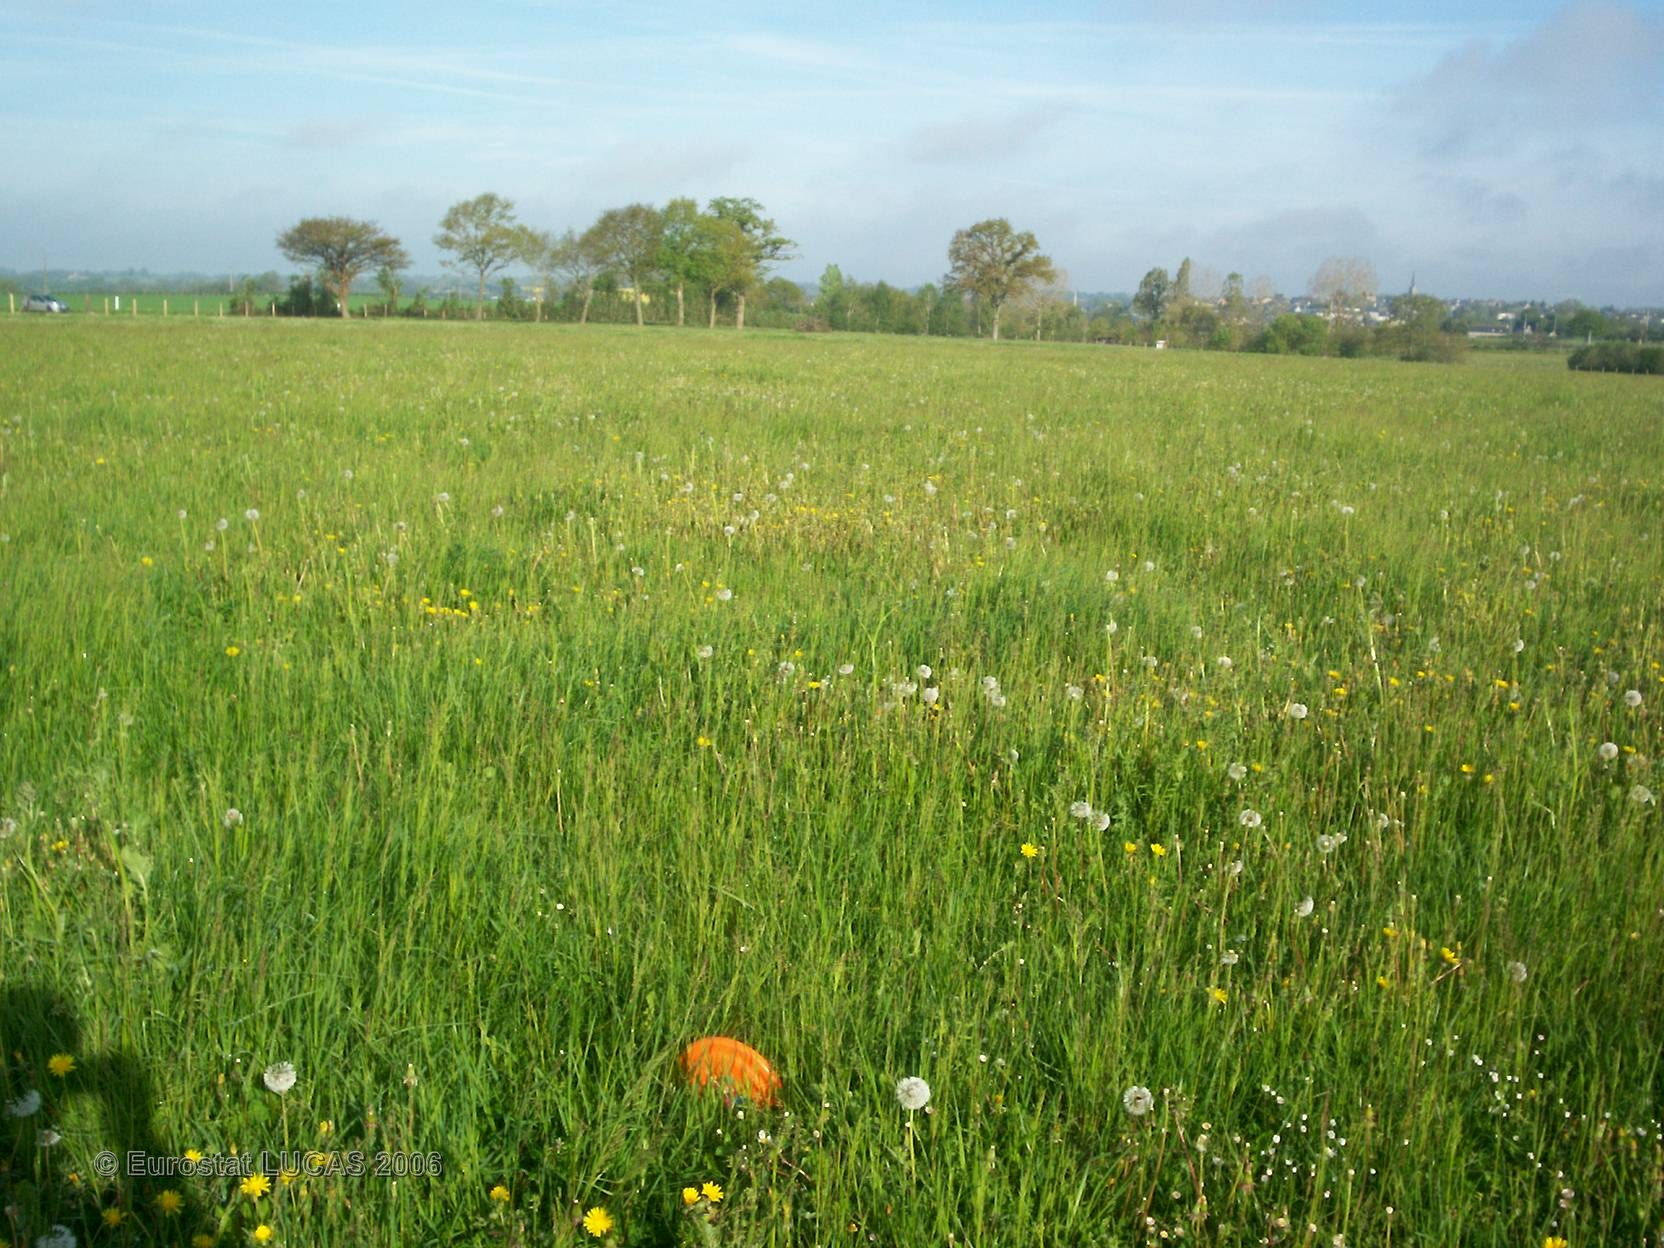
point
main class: Grassland
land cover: Grassland without tree/shrub cover
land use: Agriculture (excluding fallow land and kitchen gardens)
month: May
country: FR
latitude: 48.0716
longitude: -0.6240
